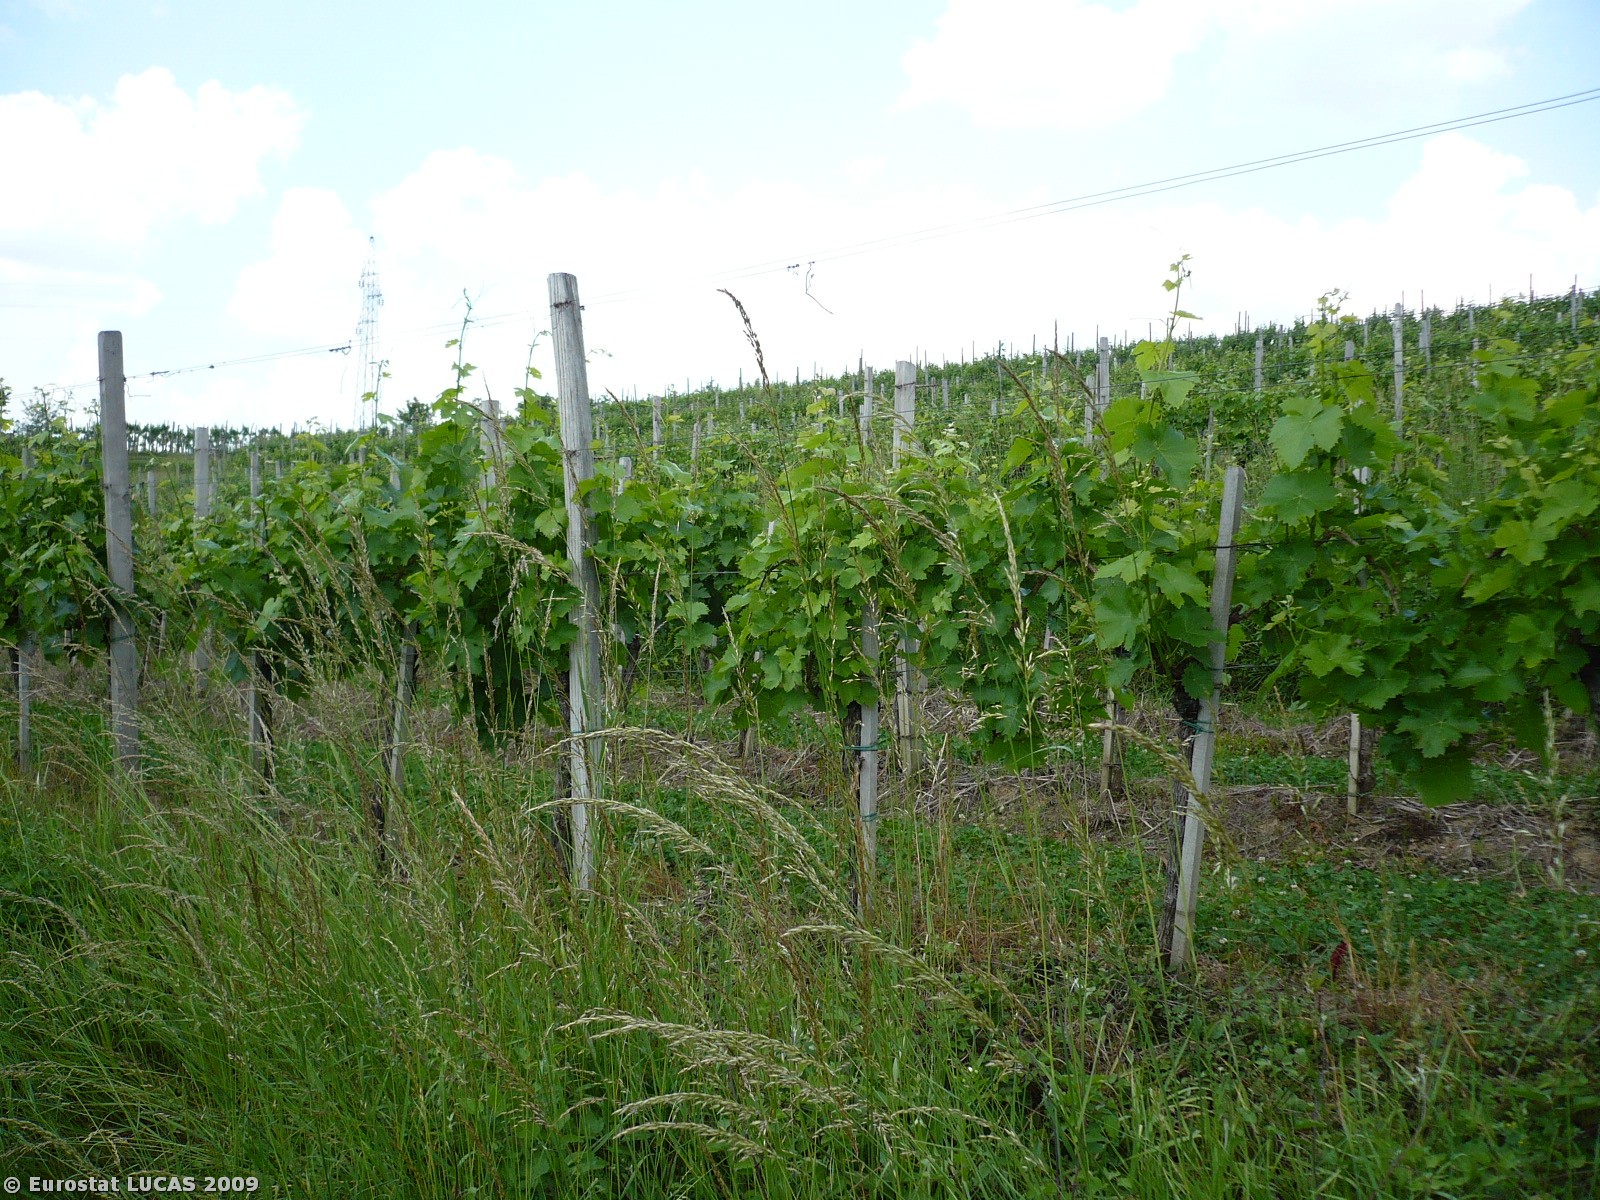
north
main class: Cropland
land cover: Vineyards
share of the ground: > 75 %
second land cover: Grassland with sparse tree/shrub cover
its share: > 75 %
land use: Agriculture (excluding fallow land and kitchen gardens)
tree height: < 5 m
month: May
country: SI
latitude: 45.9105
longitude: 13.6444
